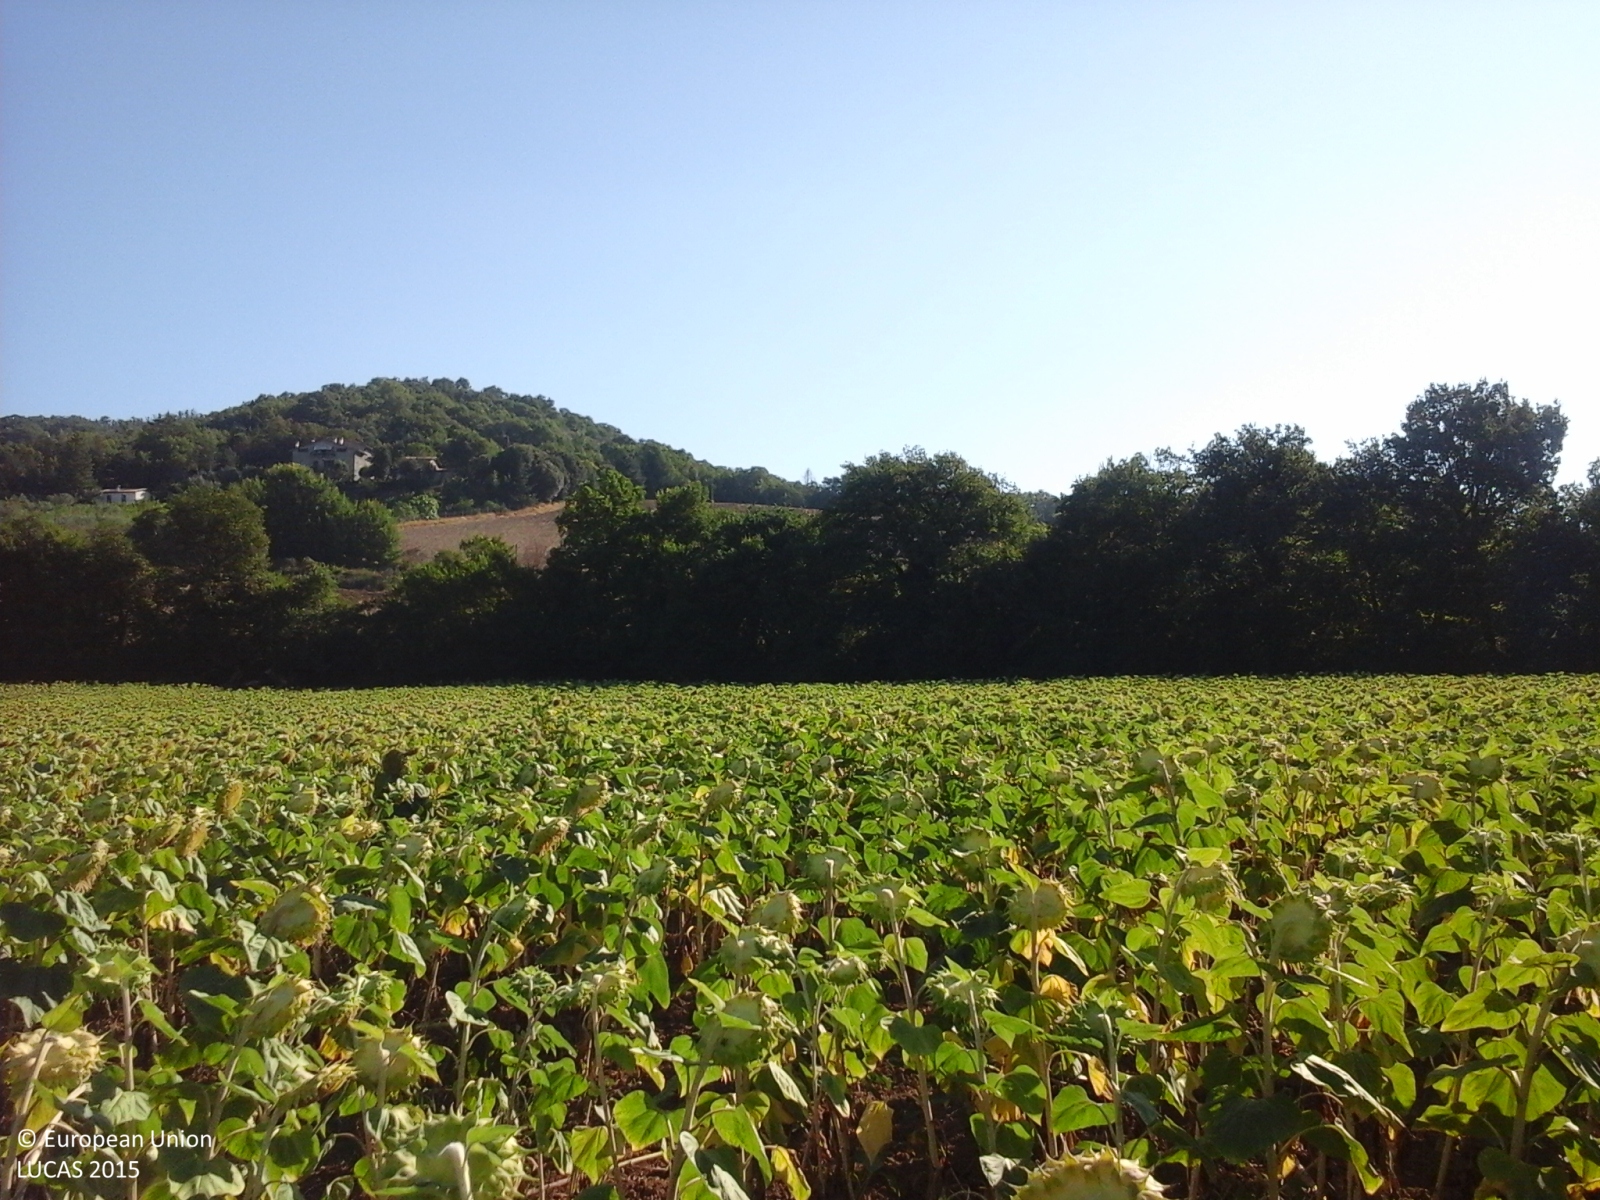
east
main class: Cropland
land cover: Sunflower
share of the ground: > 75 %
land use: Agriculture (excluding fallow land and kitchen gardens)
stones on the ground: < 10 %
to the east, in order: Sunflower; Tracks; Electric lines; Grass margins; Sunflower; Lines of trees; Common wheat
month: August
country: IT
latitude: 43.5329
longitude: 12.2091
